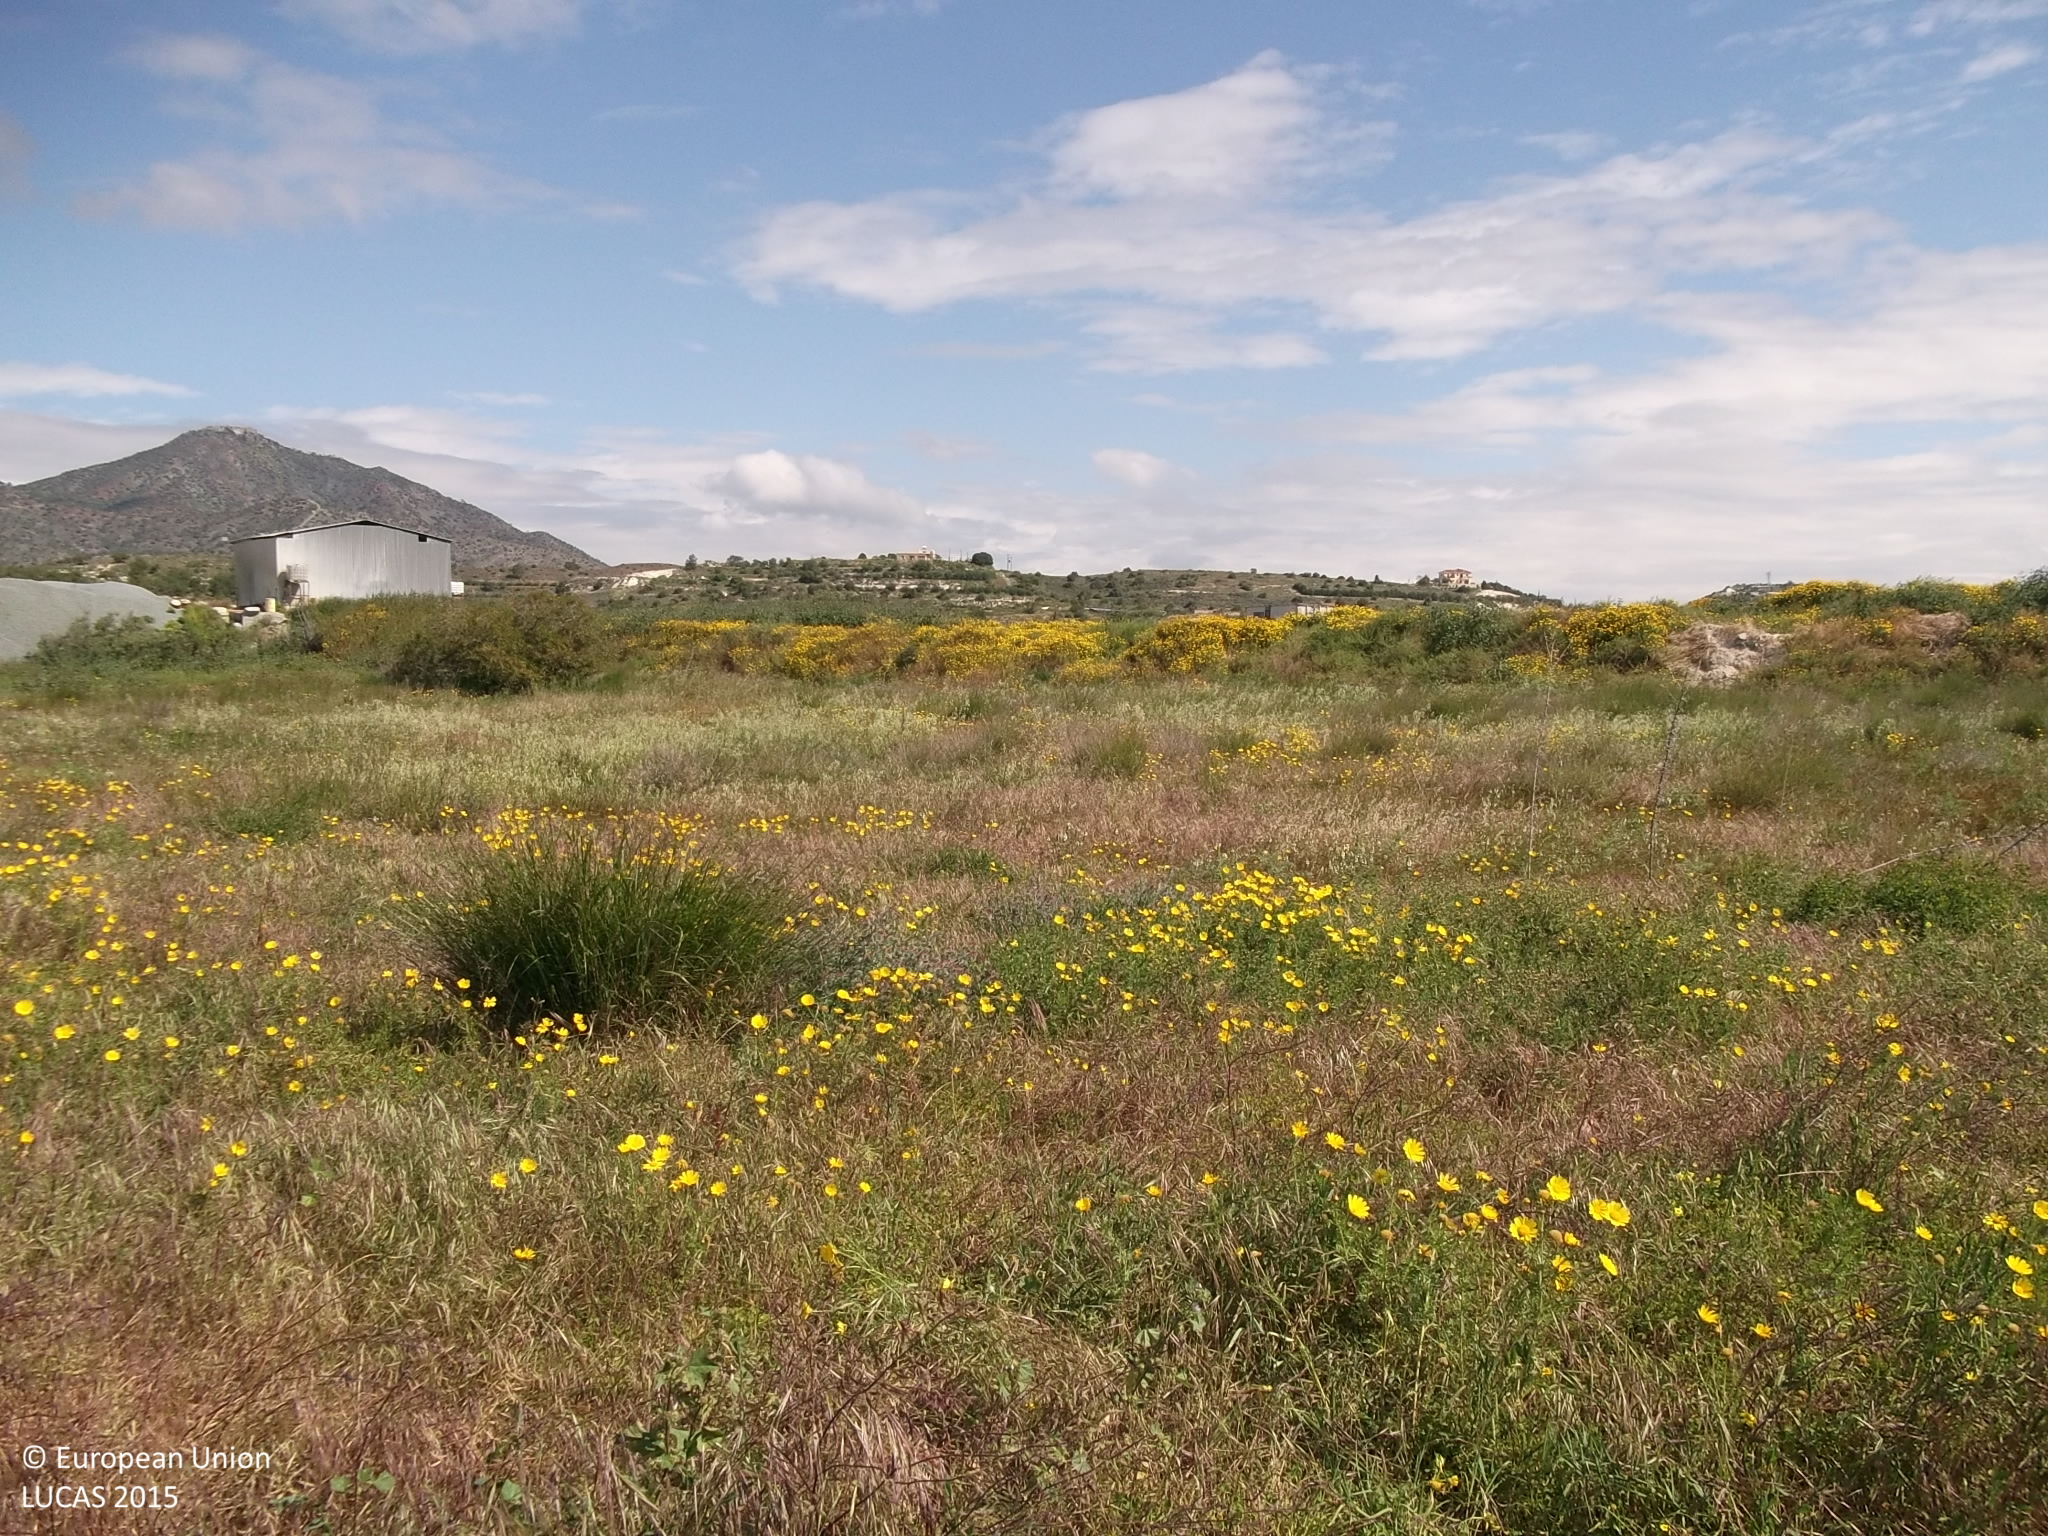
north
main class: Shrubland
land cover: Shrubland without tree cover
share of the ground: > 75 %
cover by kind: shrubs 70 %, herbaceous plants 30 %
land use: Semi-natural and natural areas not in use
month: April
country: CY
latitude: 34.8470
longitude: 33.4484
